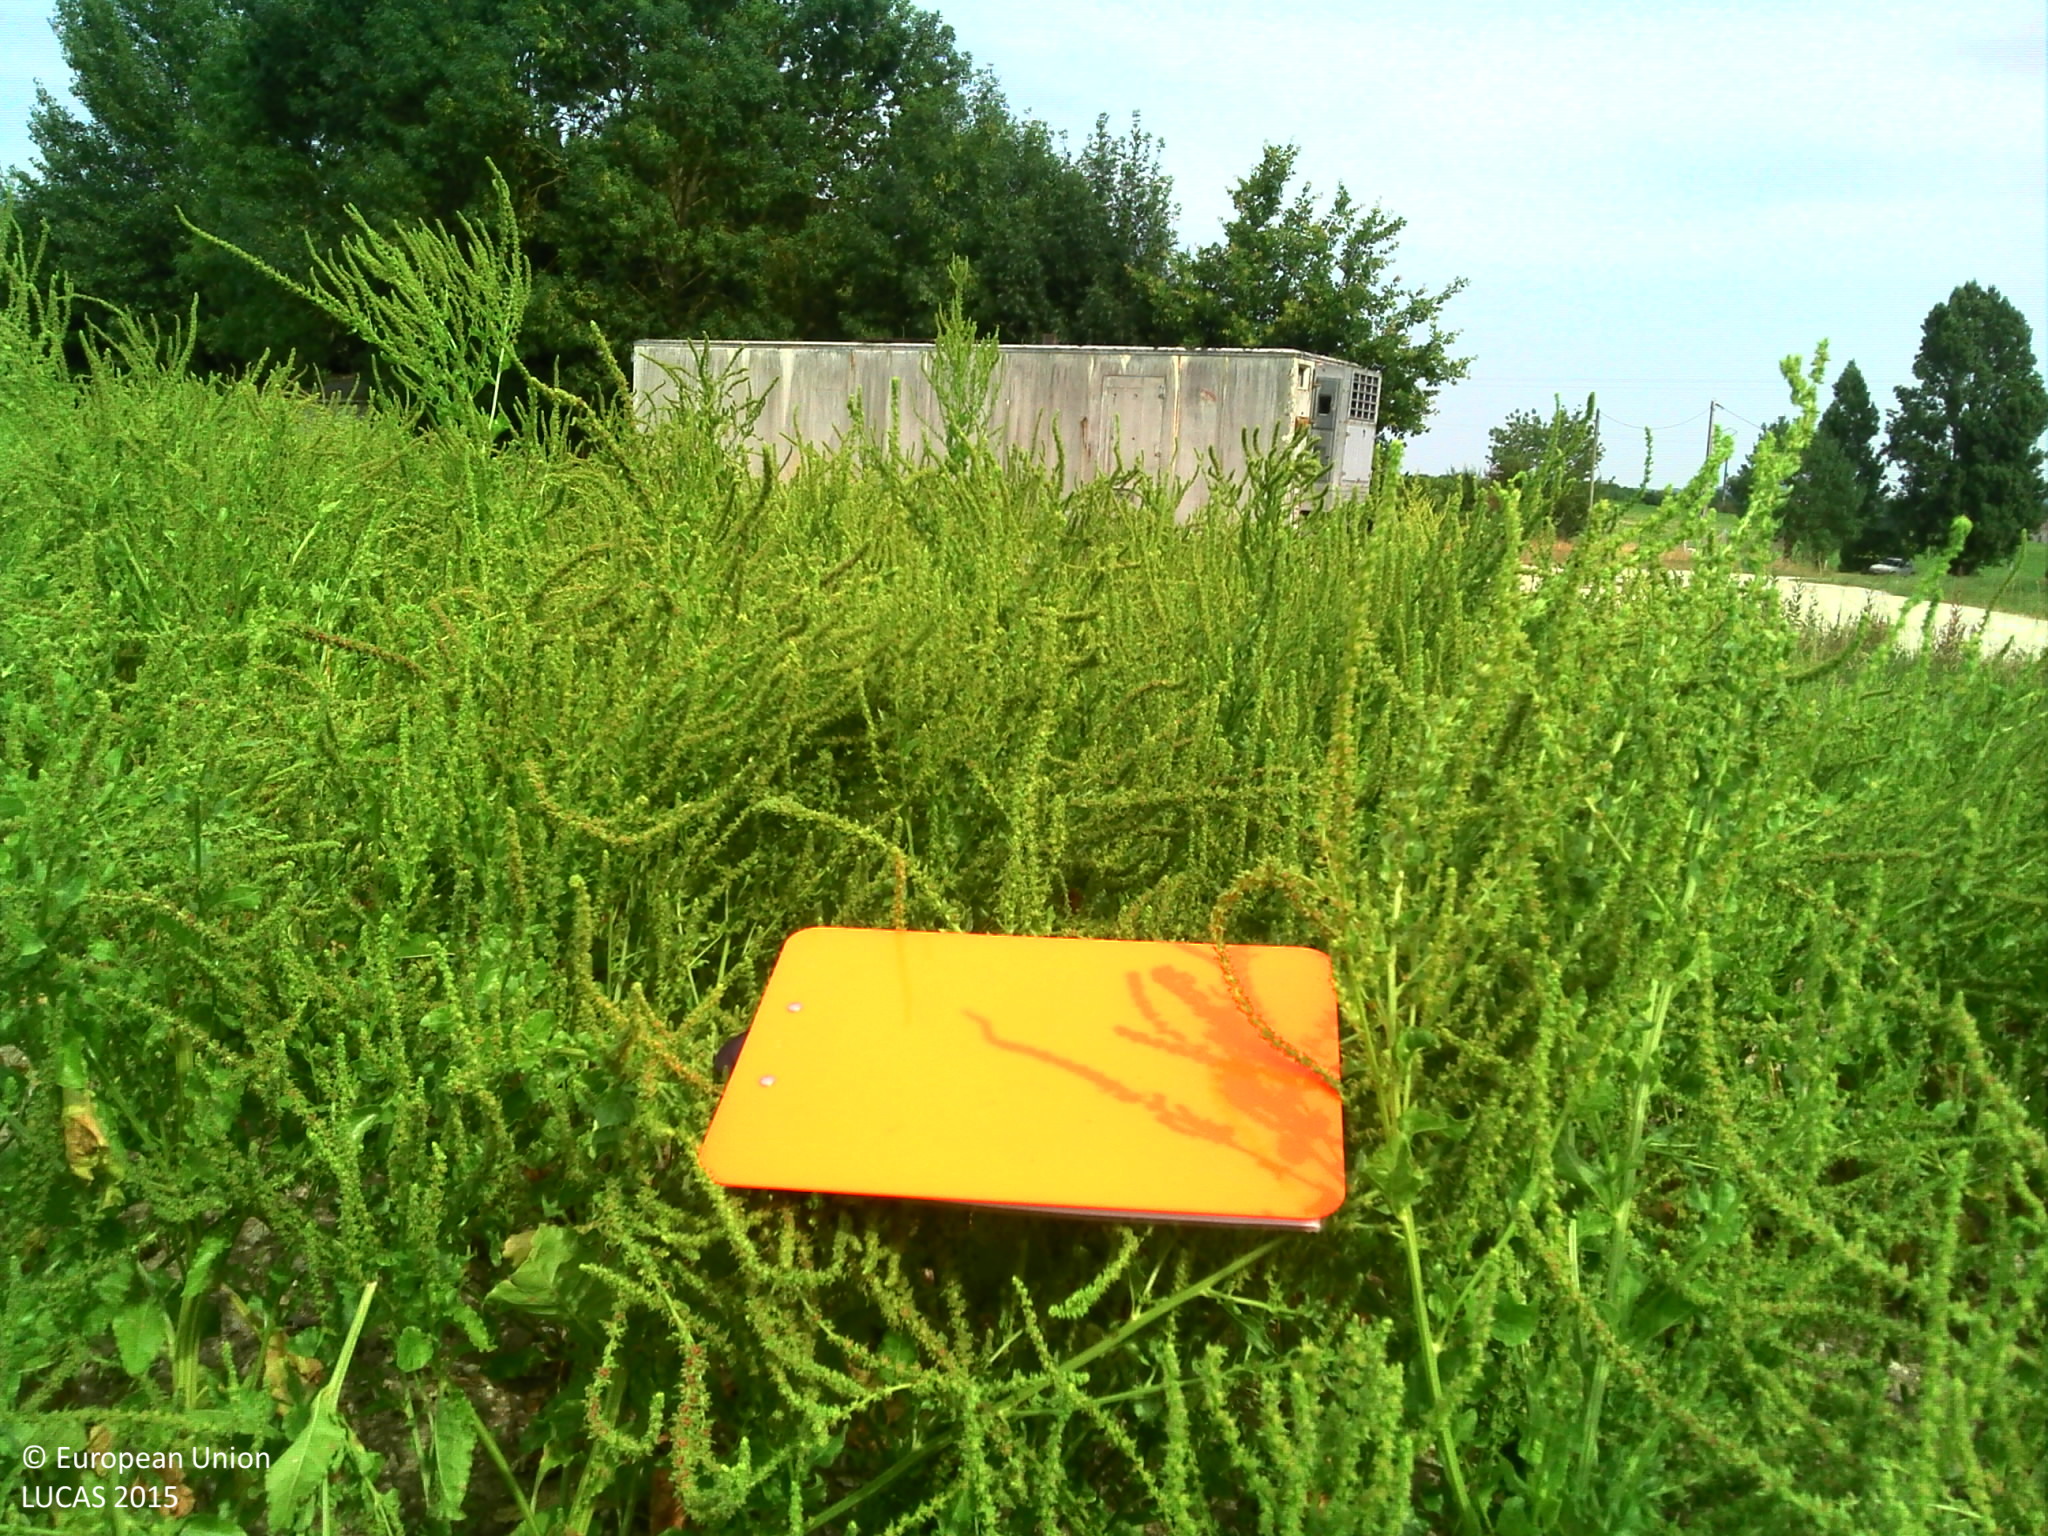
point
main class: Cropland
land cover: Sugar beet
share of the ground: > 75 %
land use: Agriculture (excluding fallow land and kitchen gardens)
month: July
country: FR
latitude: 44.4744
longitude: 0.8805
